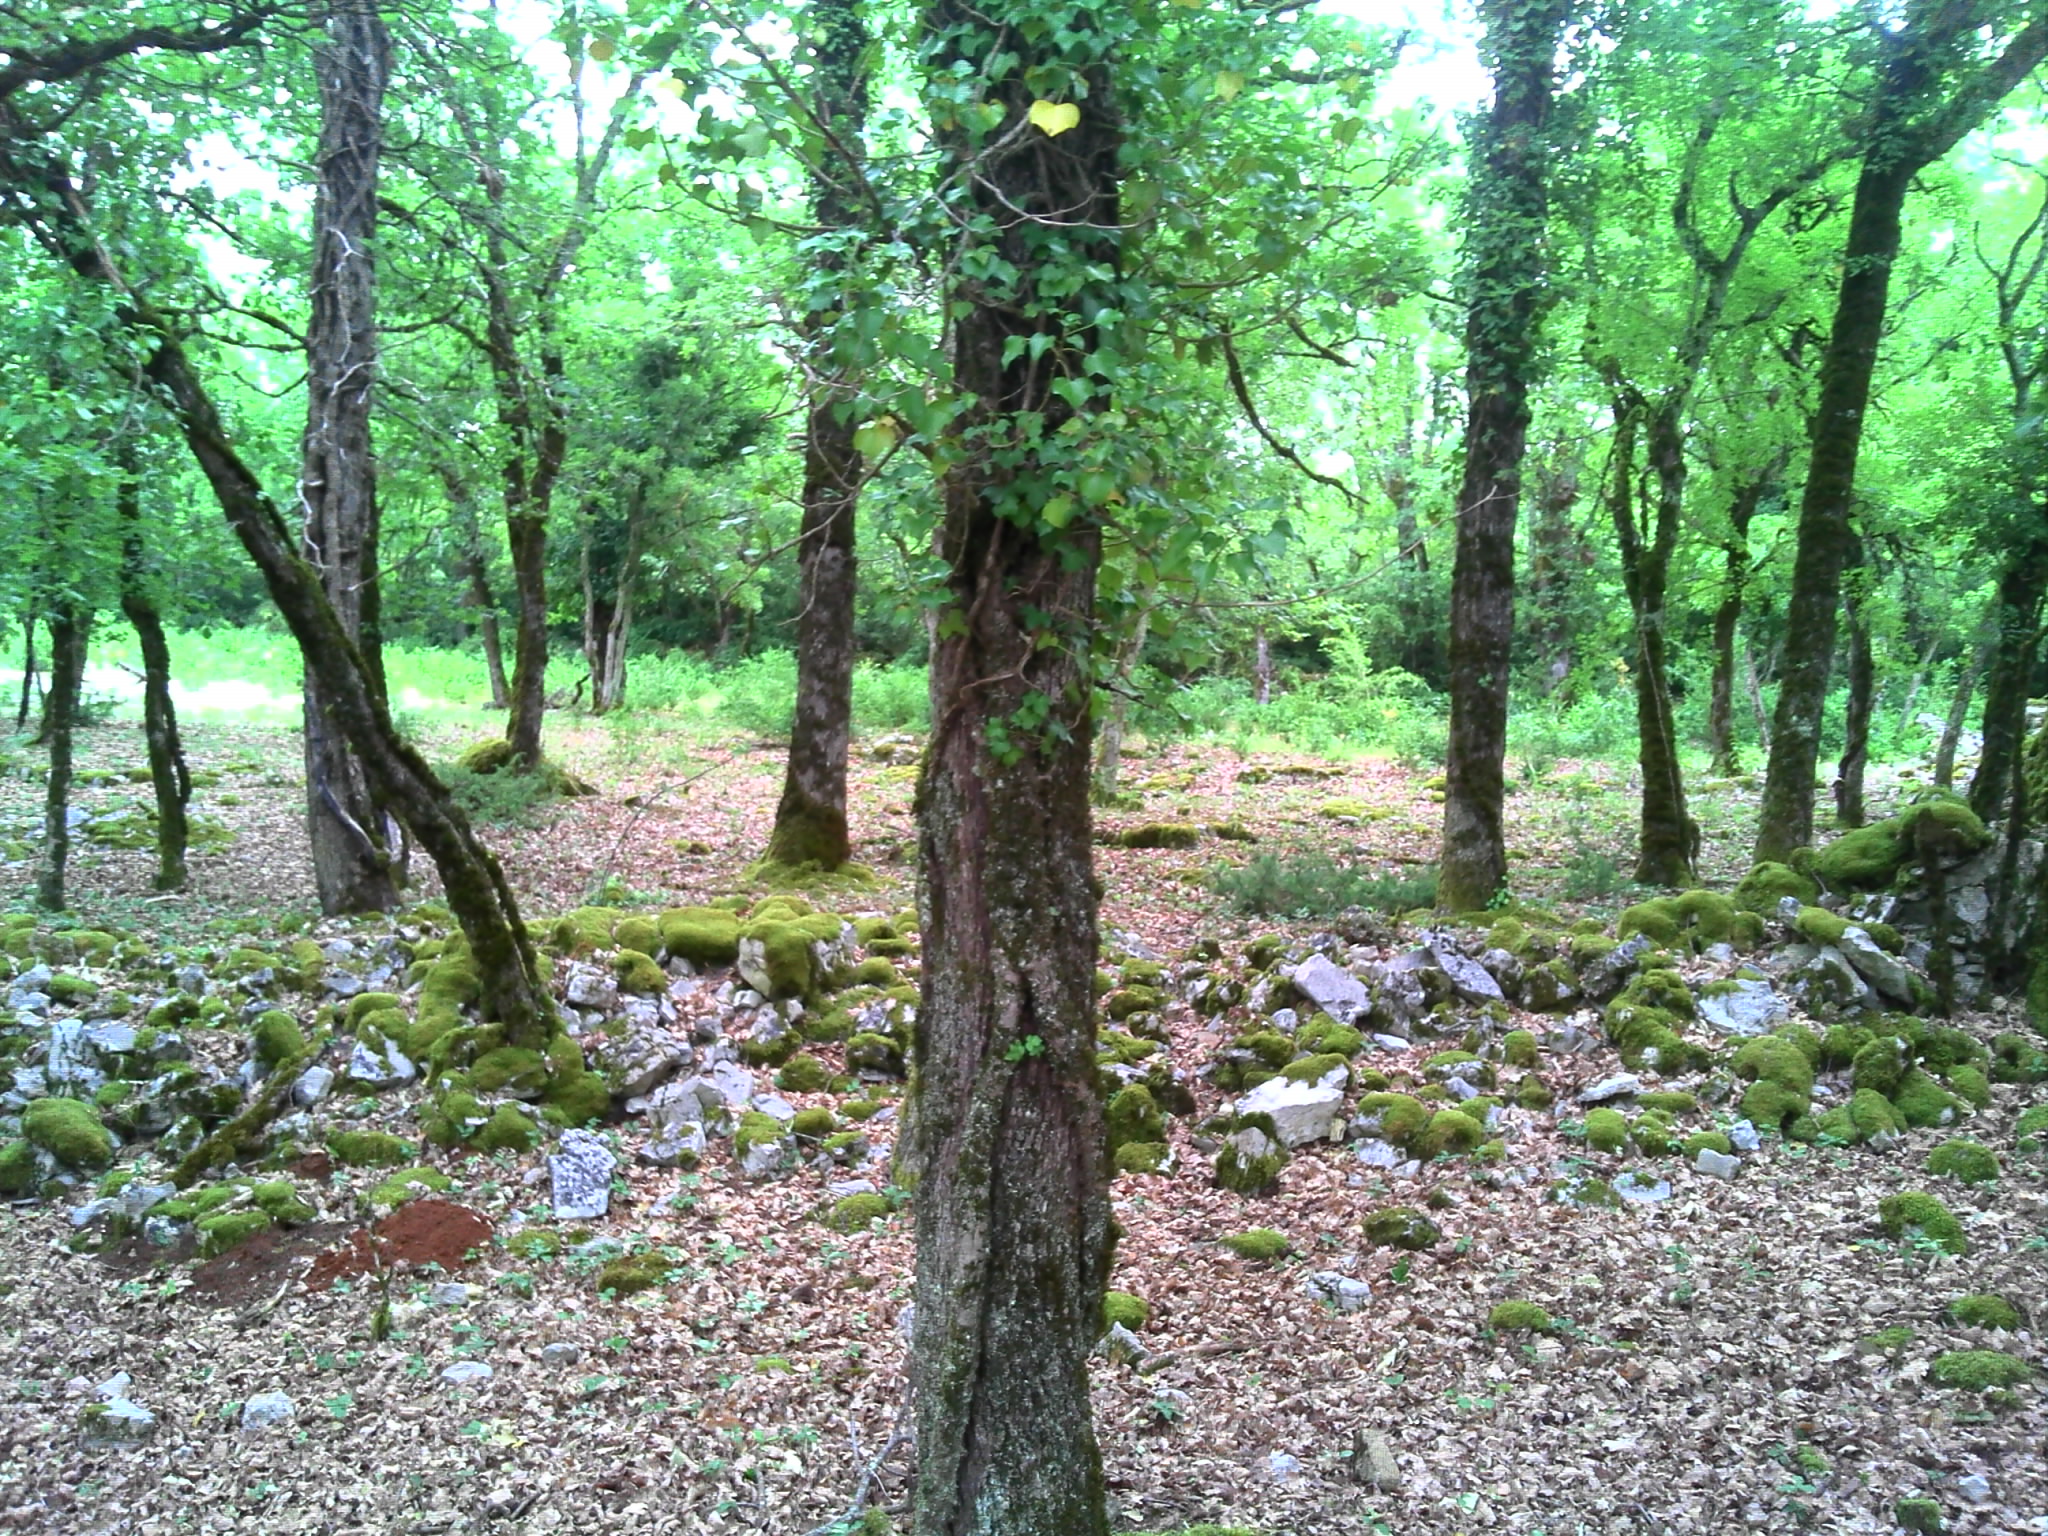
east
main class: Woodland
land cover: Broadleaved woodland
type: acidophilous oak and oak-birch forest
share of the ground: > 75 %
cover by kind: broadleaved forest trees 90 %, herbaceous plants 10 %
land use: Forestry
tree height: > 5 m
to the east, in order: Broadleaved woodland; Dry stone walls; Broadleaved woodland; Dry stone walls; Managed hedges; Grassland with sparse tree/shrub cover; Managed hedges; Grassland with sparse tree/shrub cover; Broadleaved woodland; Grassland with sparse tree/shrub cover; Broadleaved woodland; Fences; Dry stone walls; Grassland with sparse tree/shrub cover; Lines of trees; Fences; Tracks; Broadleaved woodland
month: June
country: FR
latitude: 44.4440
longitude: 1.8202
